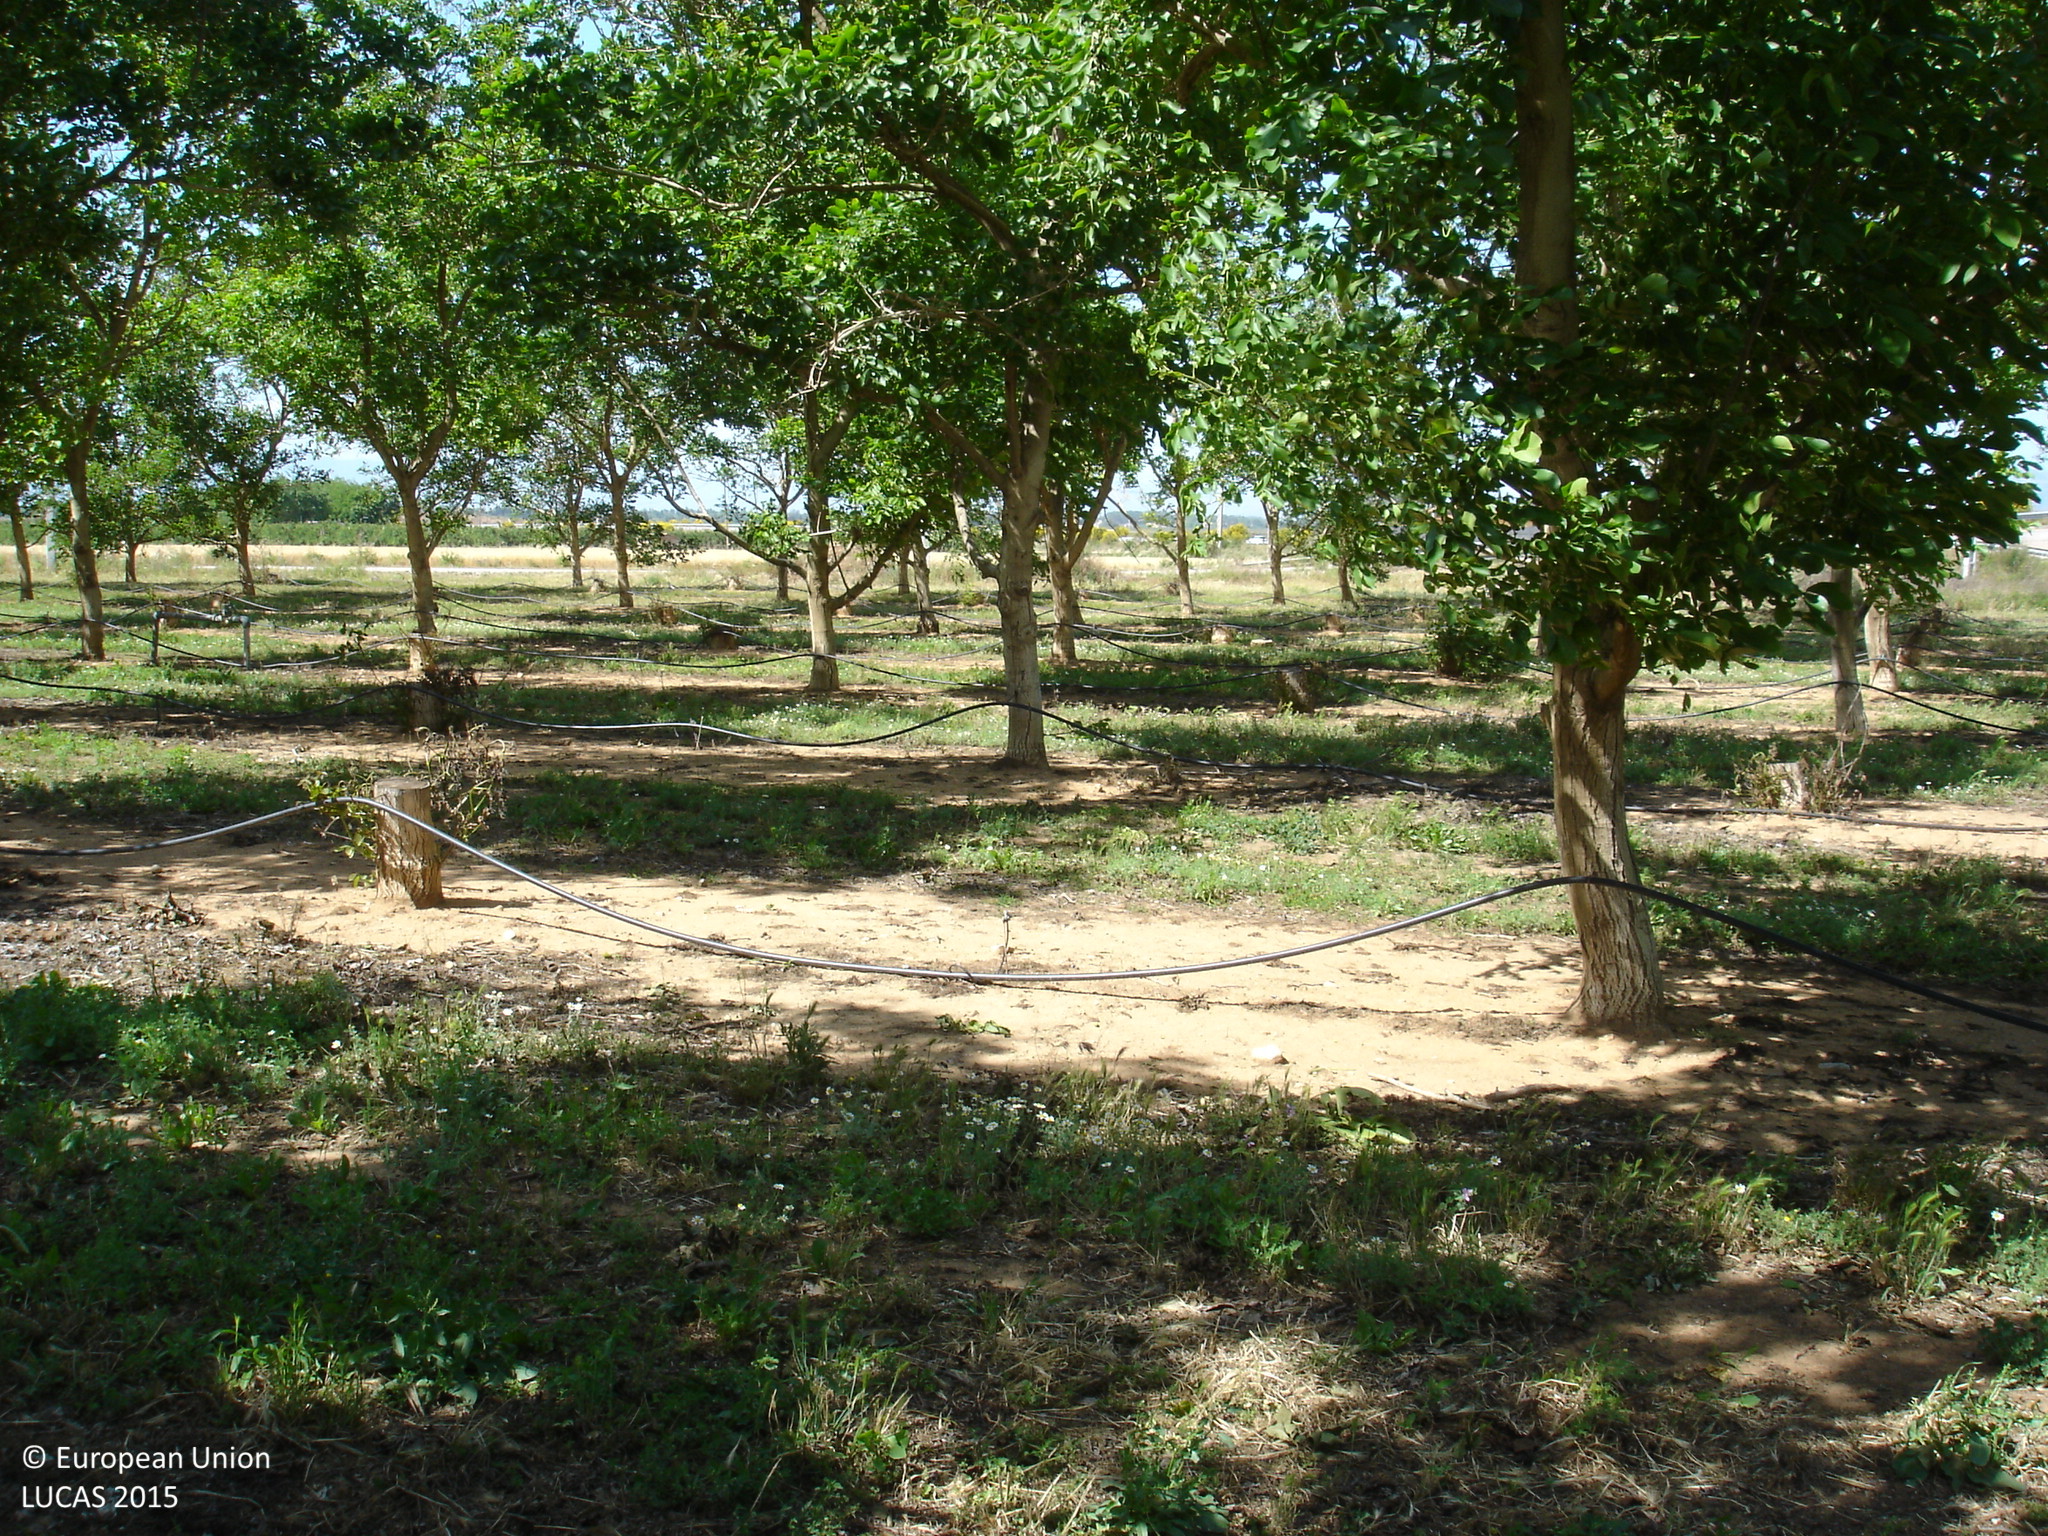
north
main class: Cropland
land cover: Nuts trees
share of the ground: > 75 %
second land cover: Spontaneously vegetated surfaces
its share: 25 - 50 %
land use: Agriculture (excluding fallow land and kitchen gardens)
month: May
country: ES
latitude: 42.1438
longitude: 3.0574
